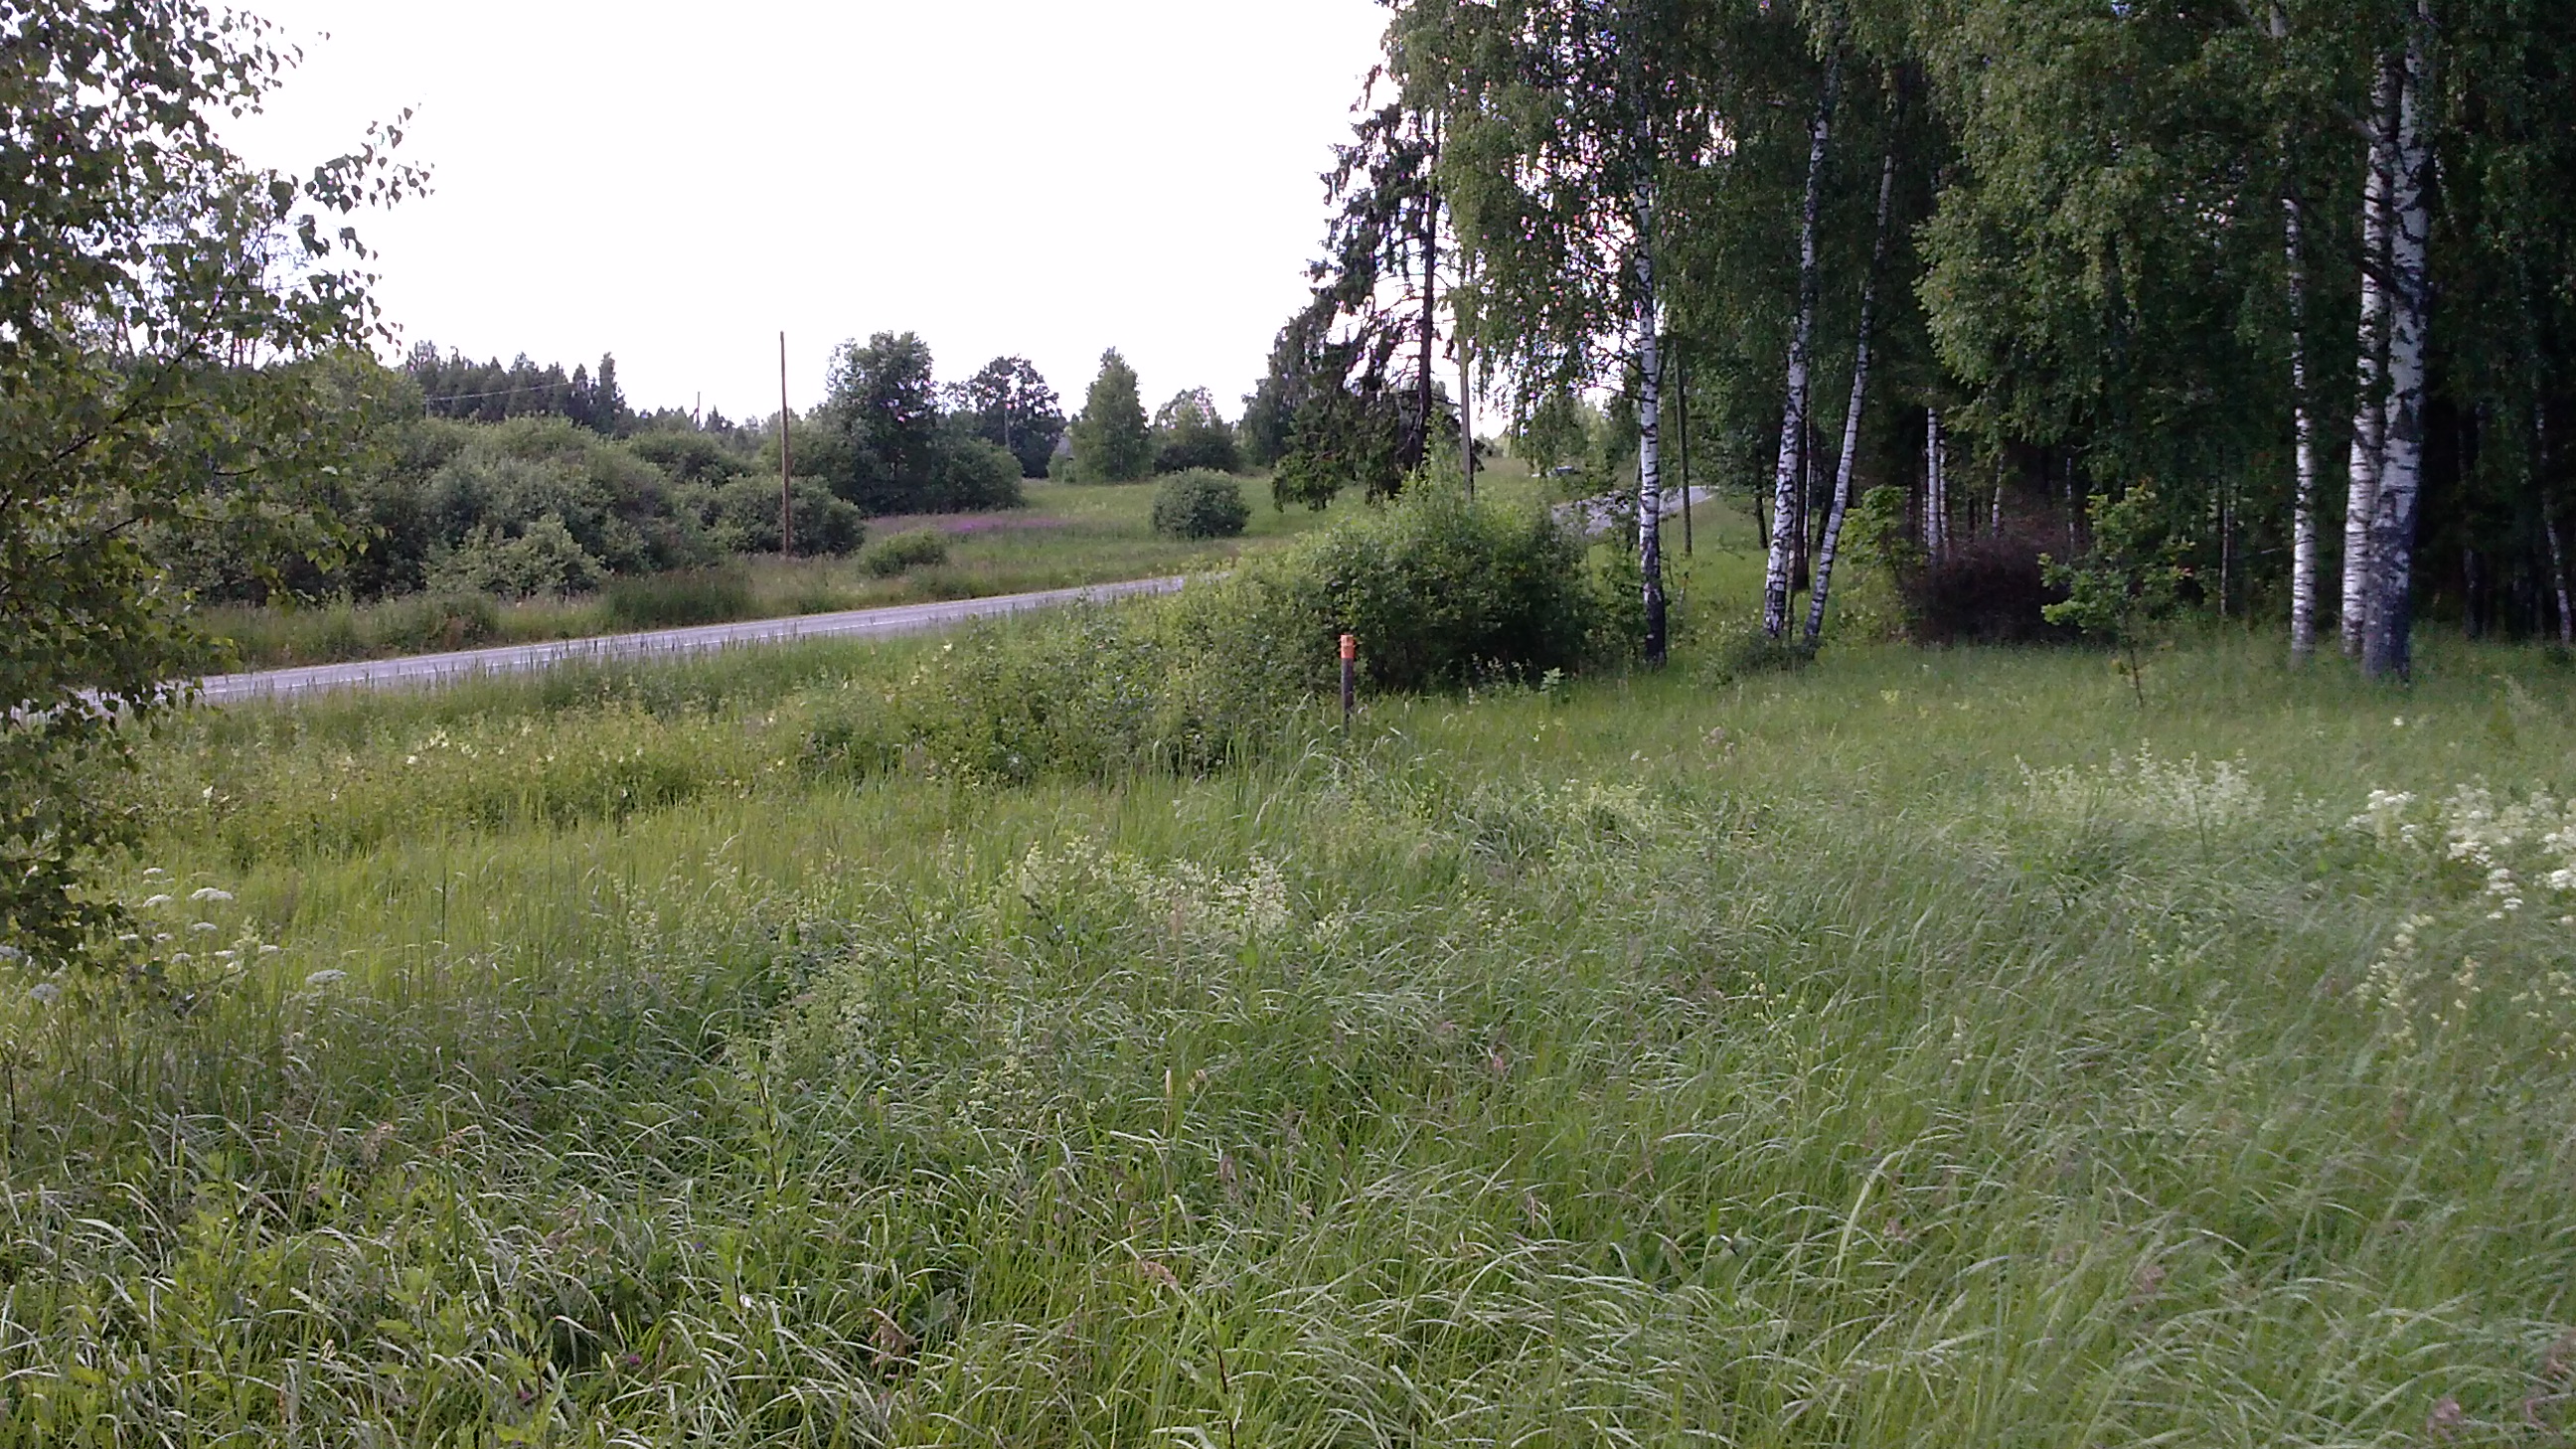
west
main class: Grassland
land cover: Grassland without tree/shrub cover
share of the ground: > 75 %
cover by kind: herbaceous plants 100 %
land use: Agriculture (excluding fallow land and kitchen gardens)
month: June
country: LV
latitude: 56.4825
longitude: 27.9088
